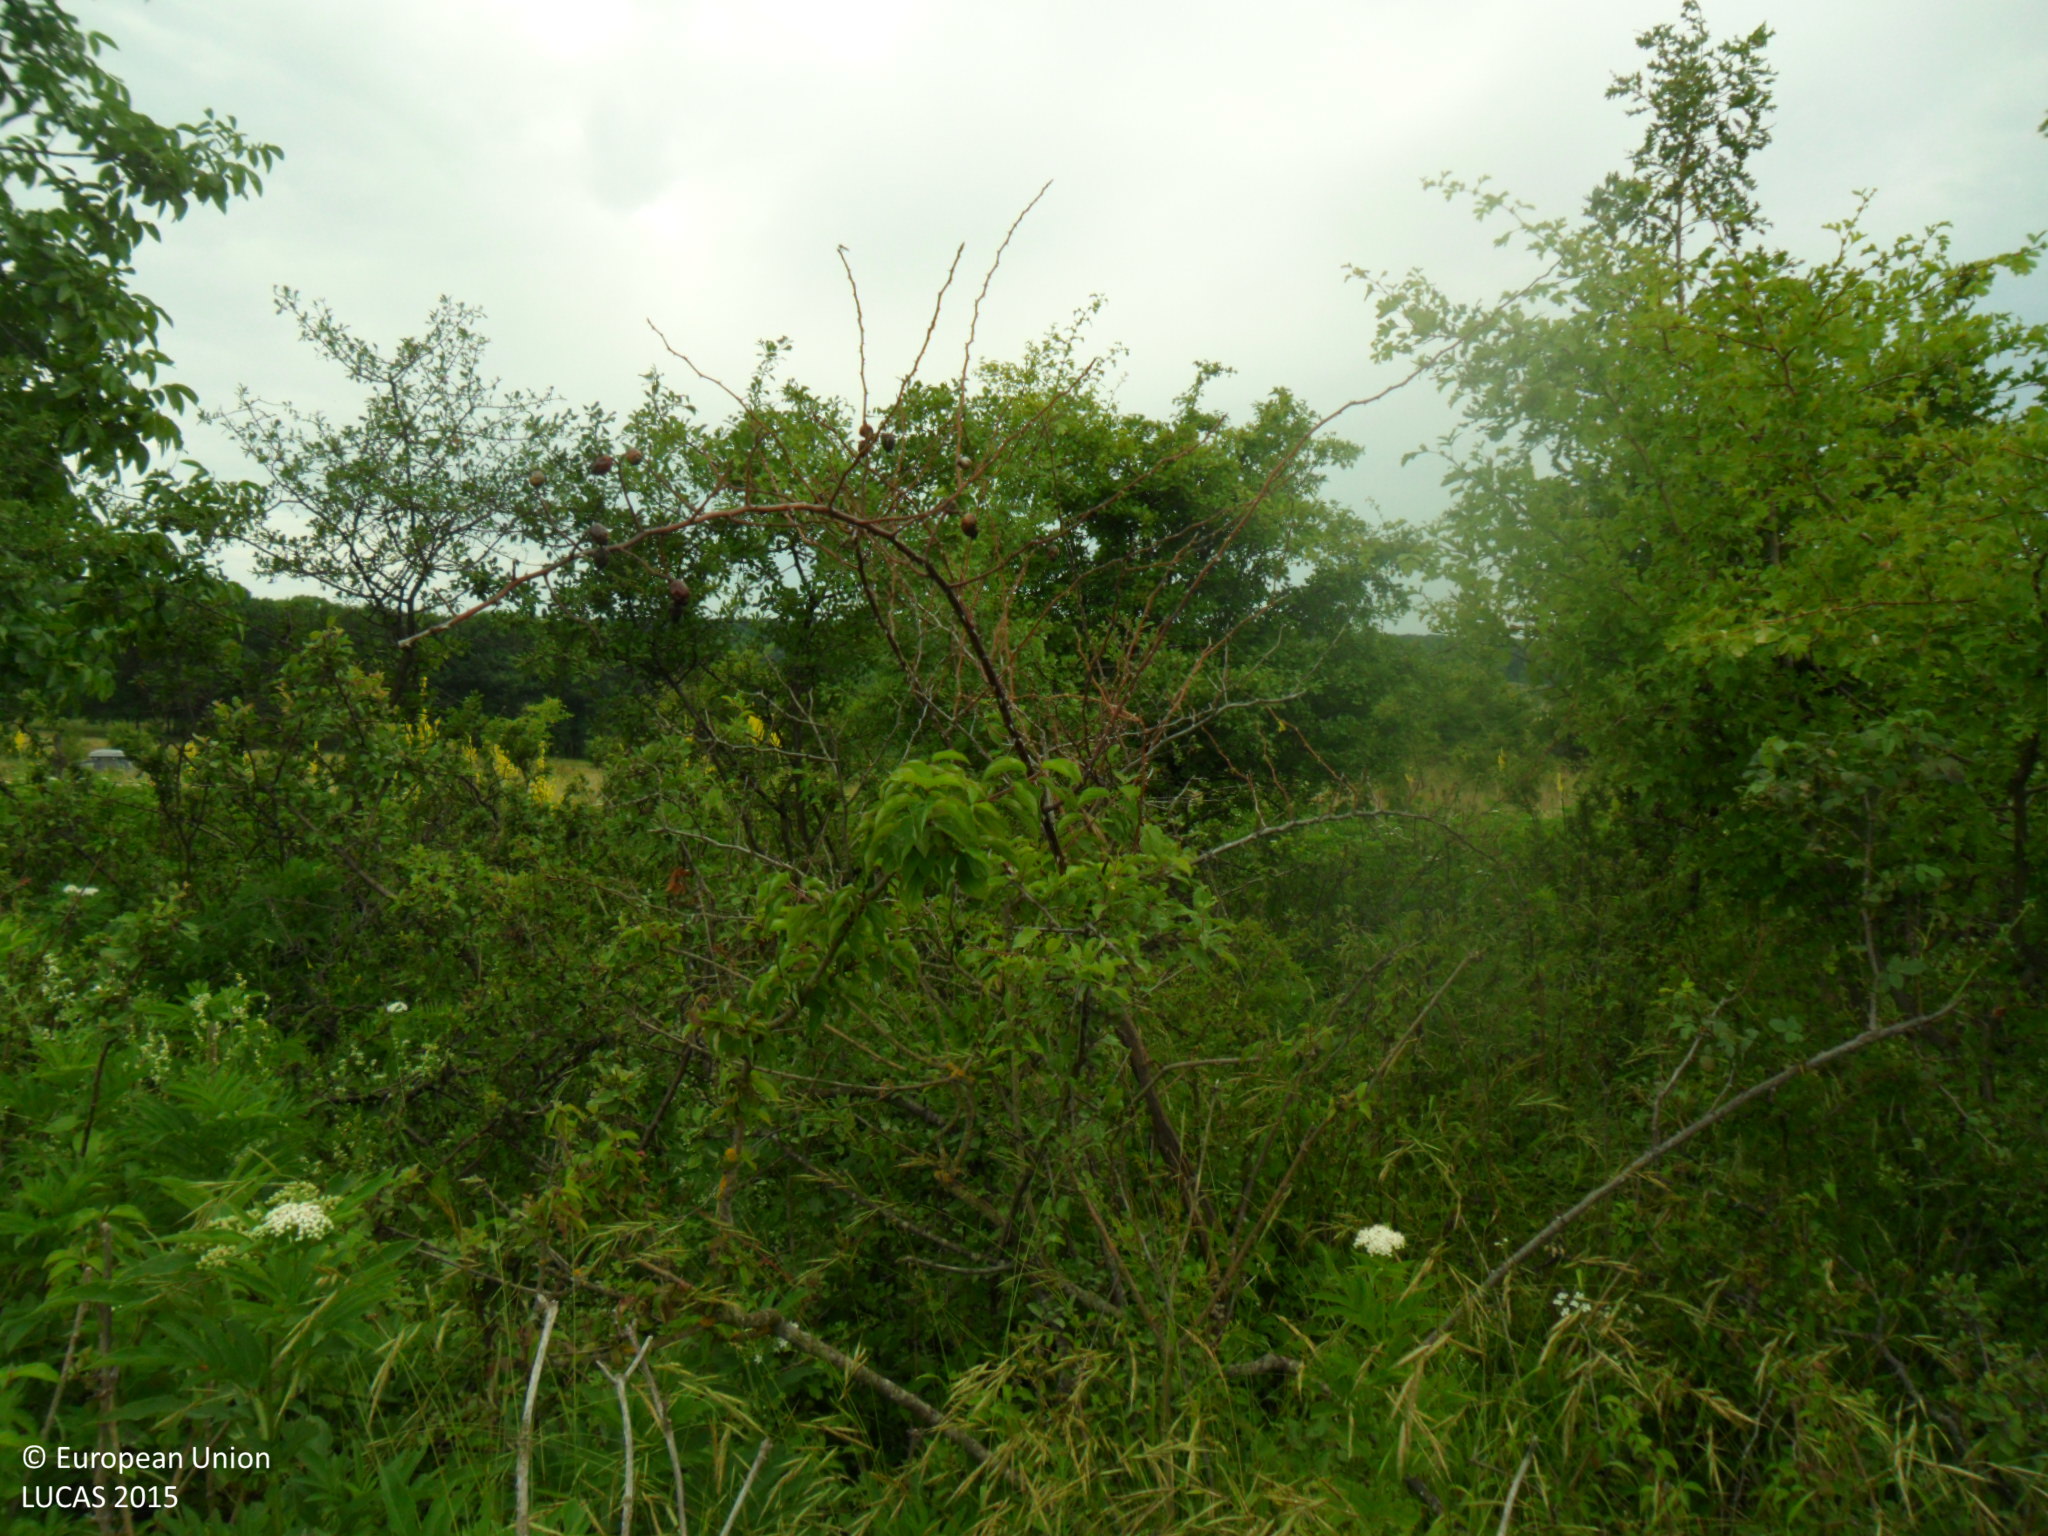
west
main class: Shrubland
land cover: Shrubland with sparse tree cover
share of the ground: > 75 %
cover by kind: herbaceous plants 60 %, shrubs 35 %, broadleaved forest trees 5 %
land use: Agriculture (excluding fallow land and kitchen gardens)
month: June
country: BG
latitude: 43.4567
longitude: 26.6309
